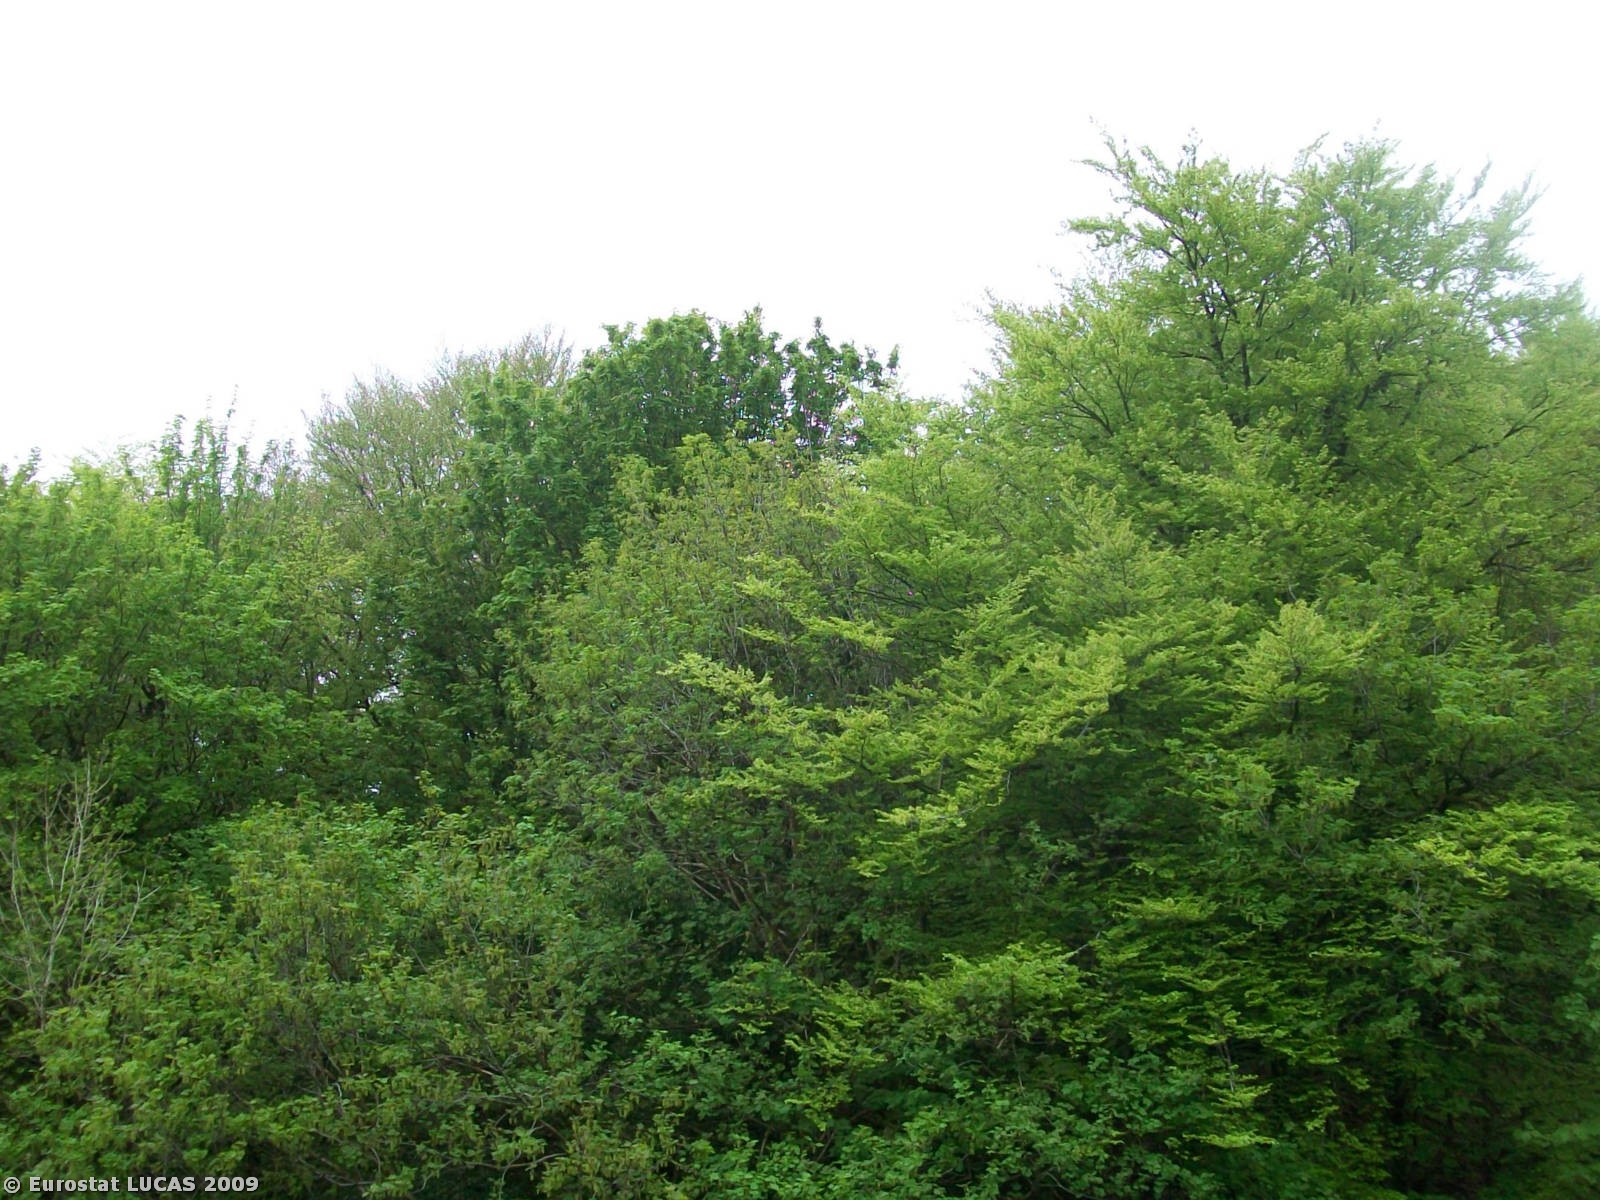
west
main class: Shrubland
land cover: Shrubland with sparse tree cover
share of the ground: > 75 %
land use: Agriculture (excluding fallow land and kitchen gardens)
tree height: > 5 m
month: May
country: GB
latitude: 50.5046
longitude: -4.2695
